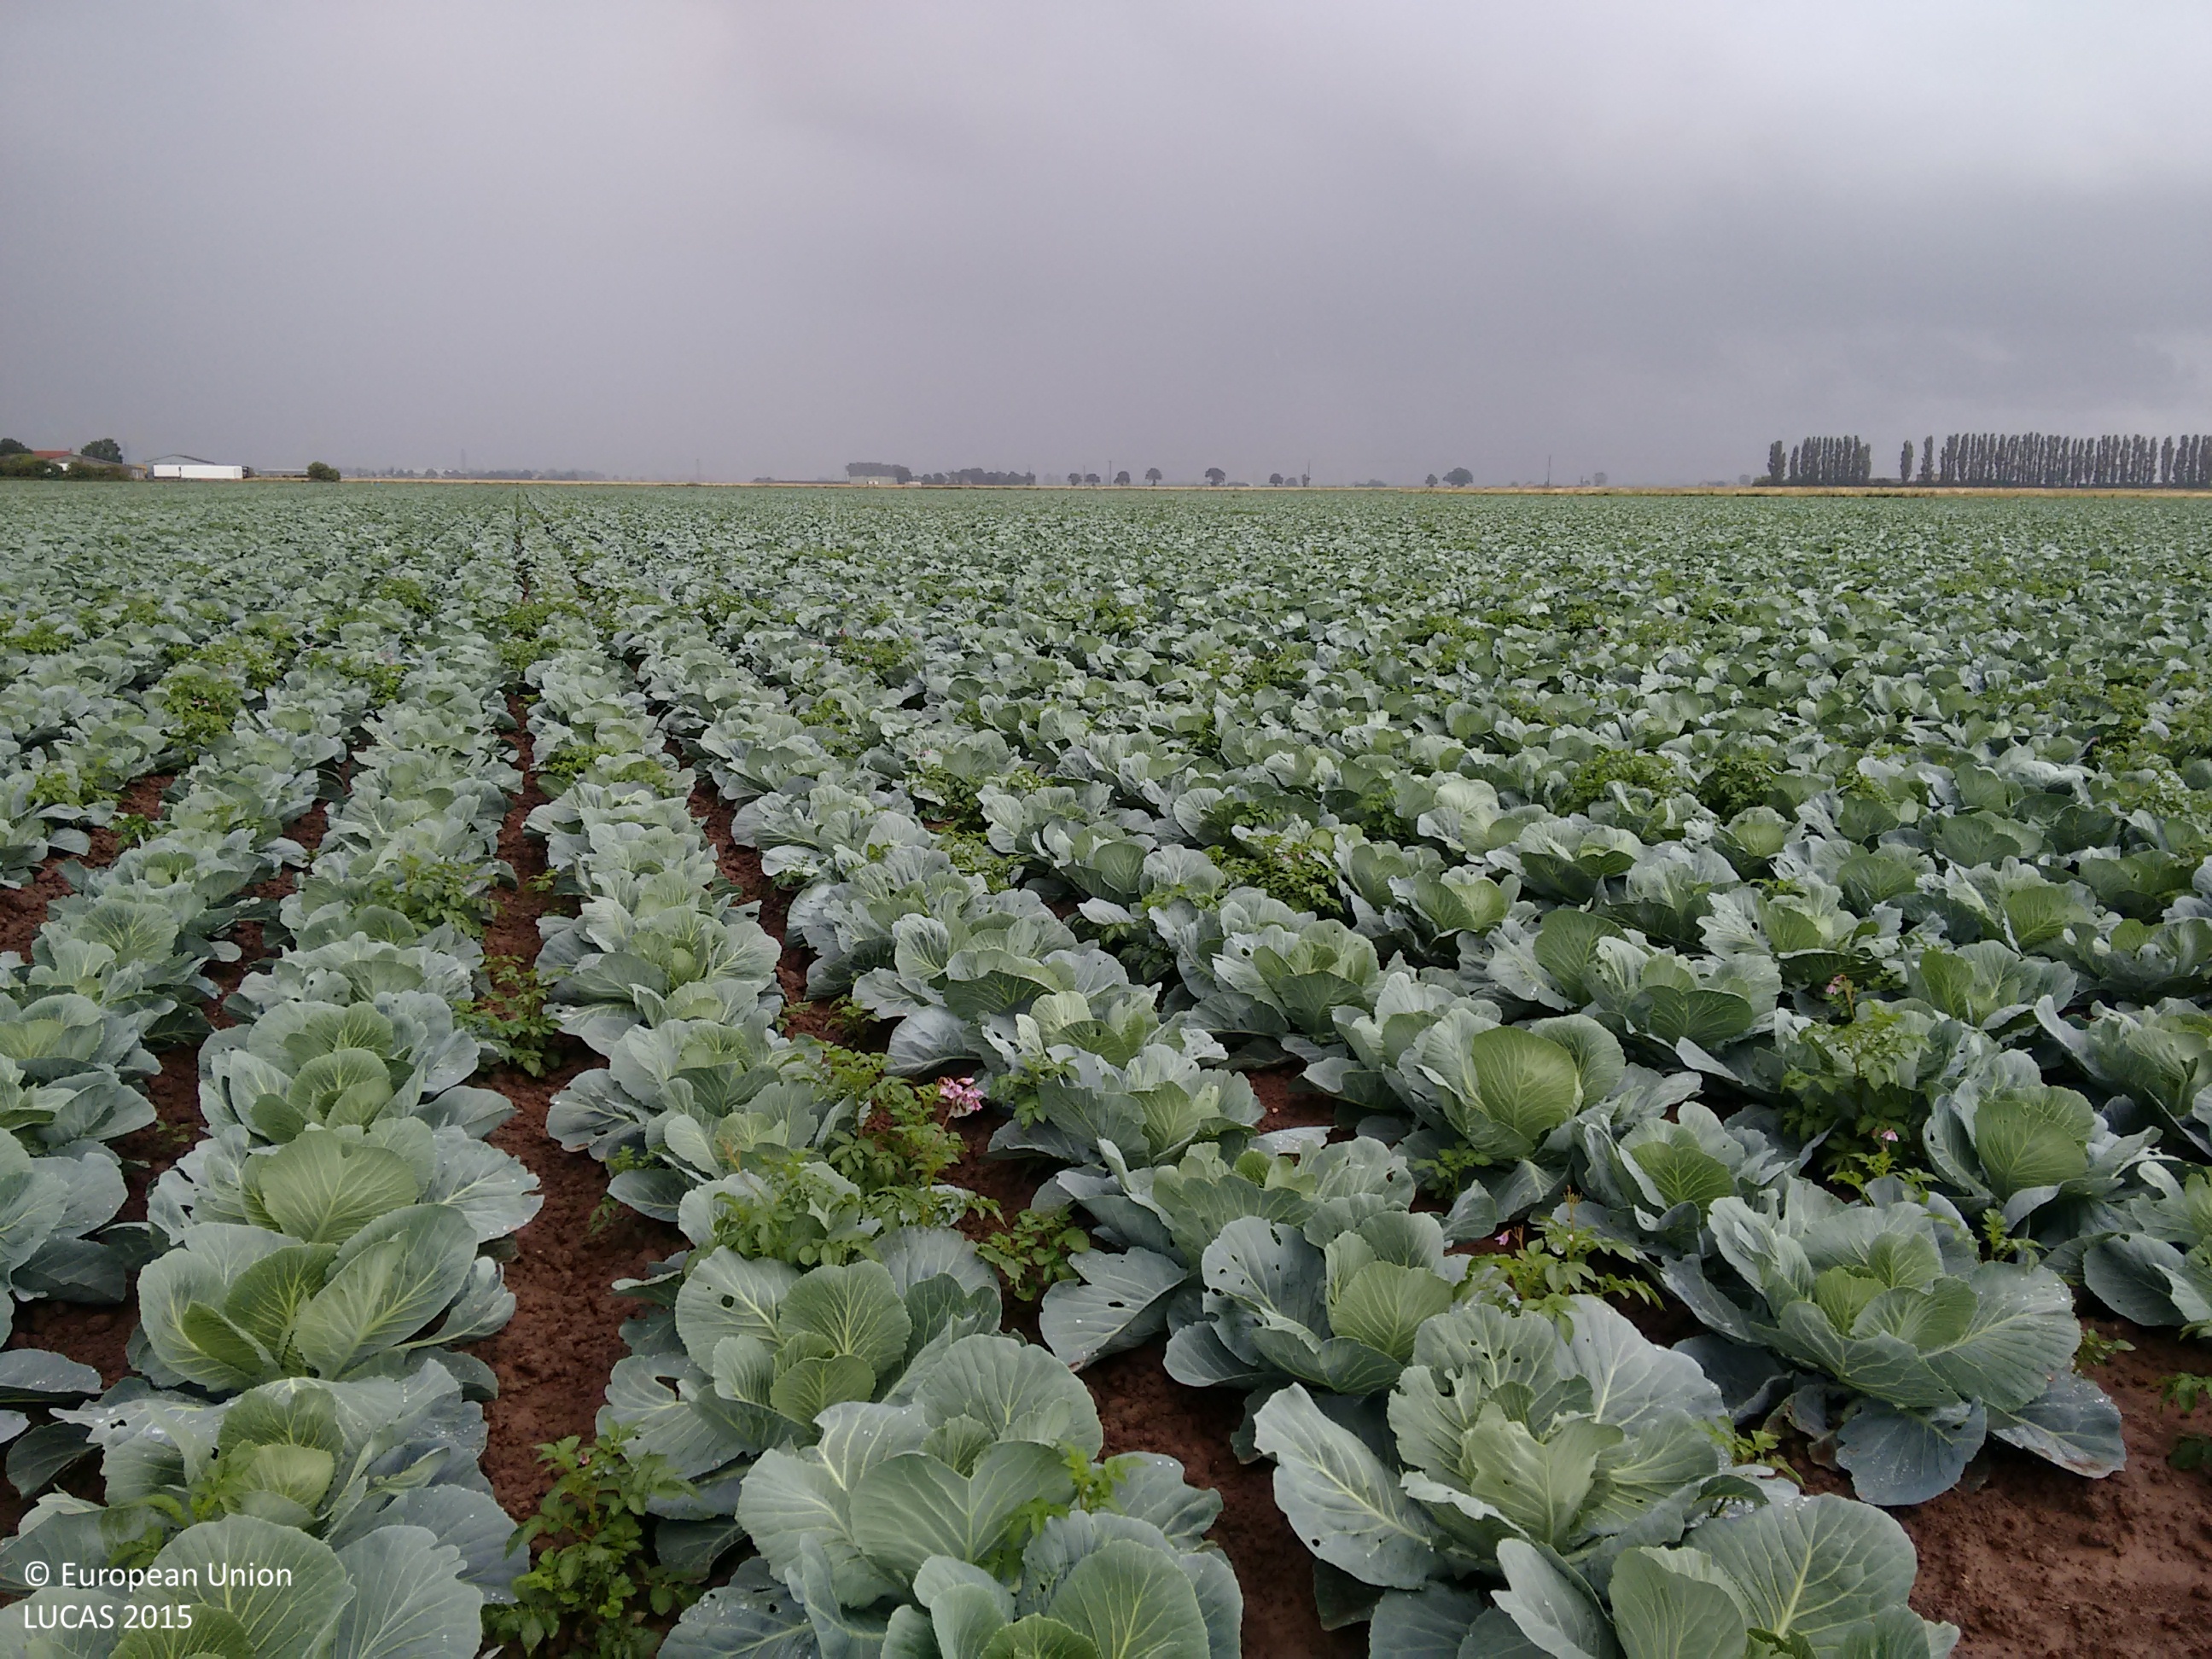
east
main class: Cropland
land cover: Other fresh vegetables
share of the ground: > 75 %
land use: Agriculture (excluding fallow land and kitchen gardens)
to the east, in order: Other fresh vegetables
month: July
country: GB
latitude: 52.8578
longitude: -0.0279
